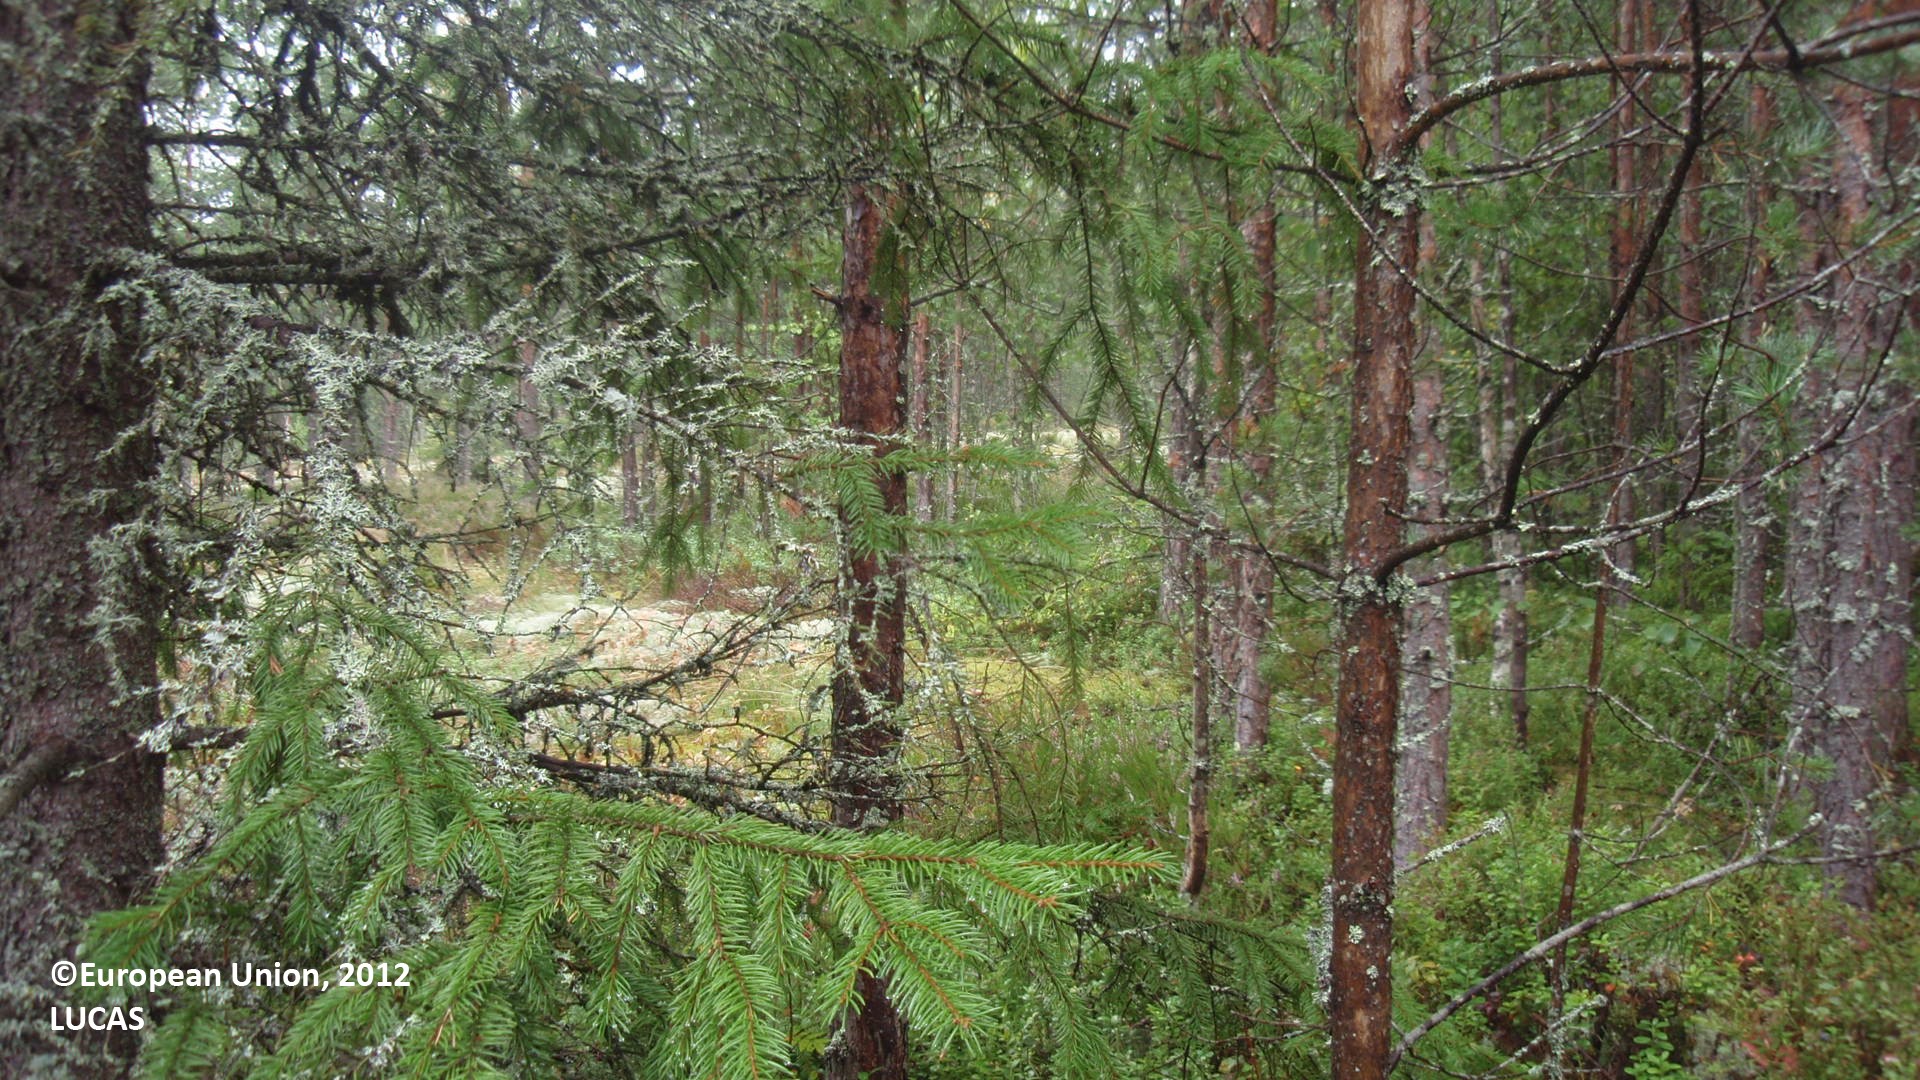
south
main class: Woodland
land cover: Pine dominated mixed woodland
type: boreal forest
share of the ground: 50 - 75 %
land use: Forestry
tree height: > 5 m
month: August
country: FI
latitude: 60.8547
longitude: 26.8586
